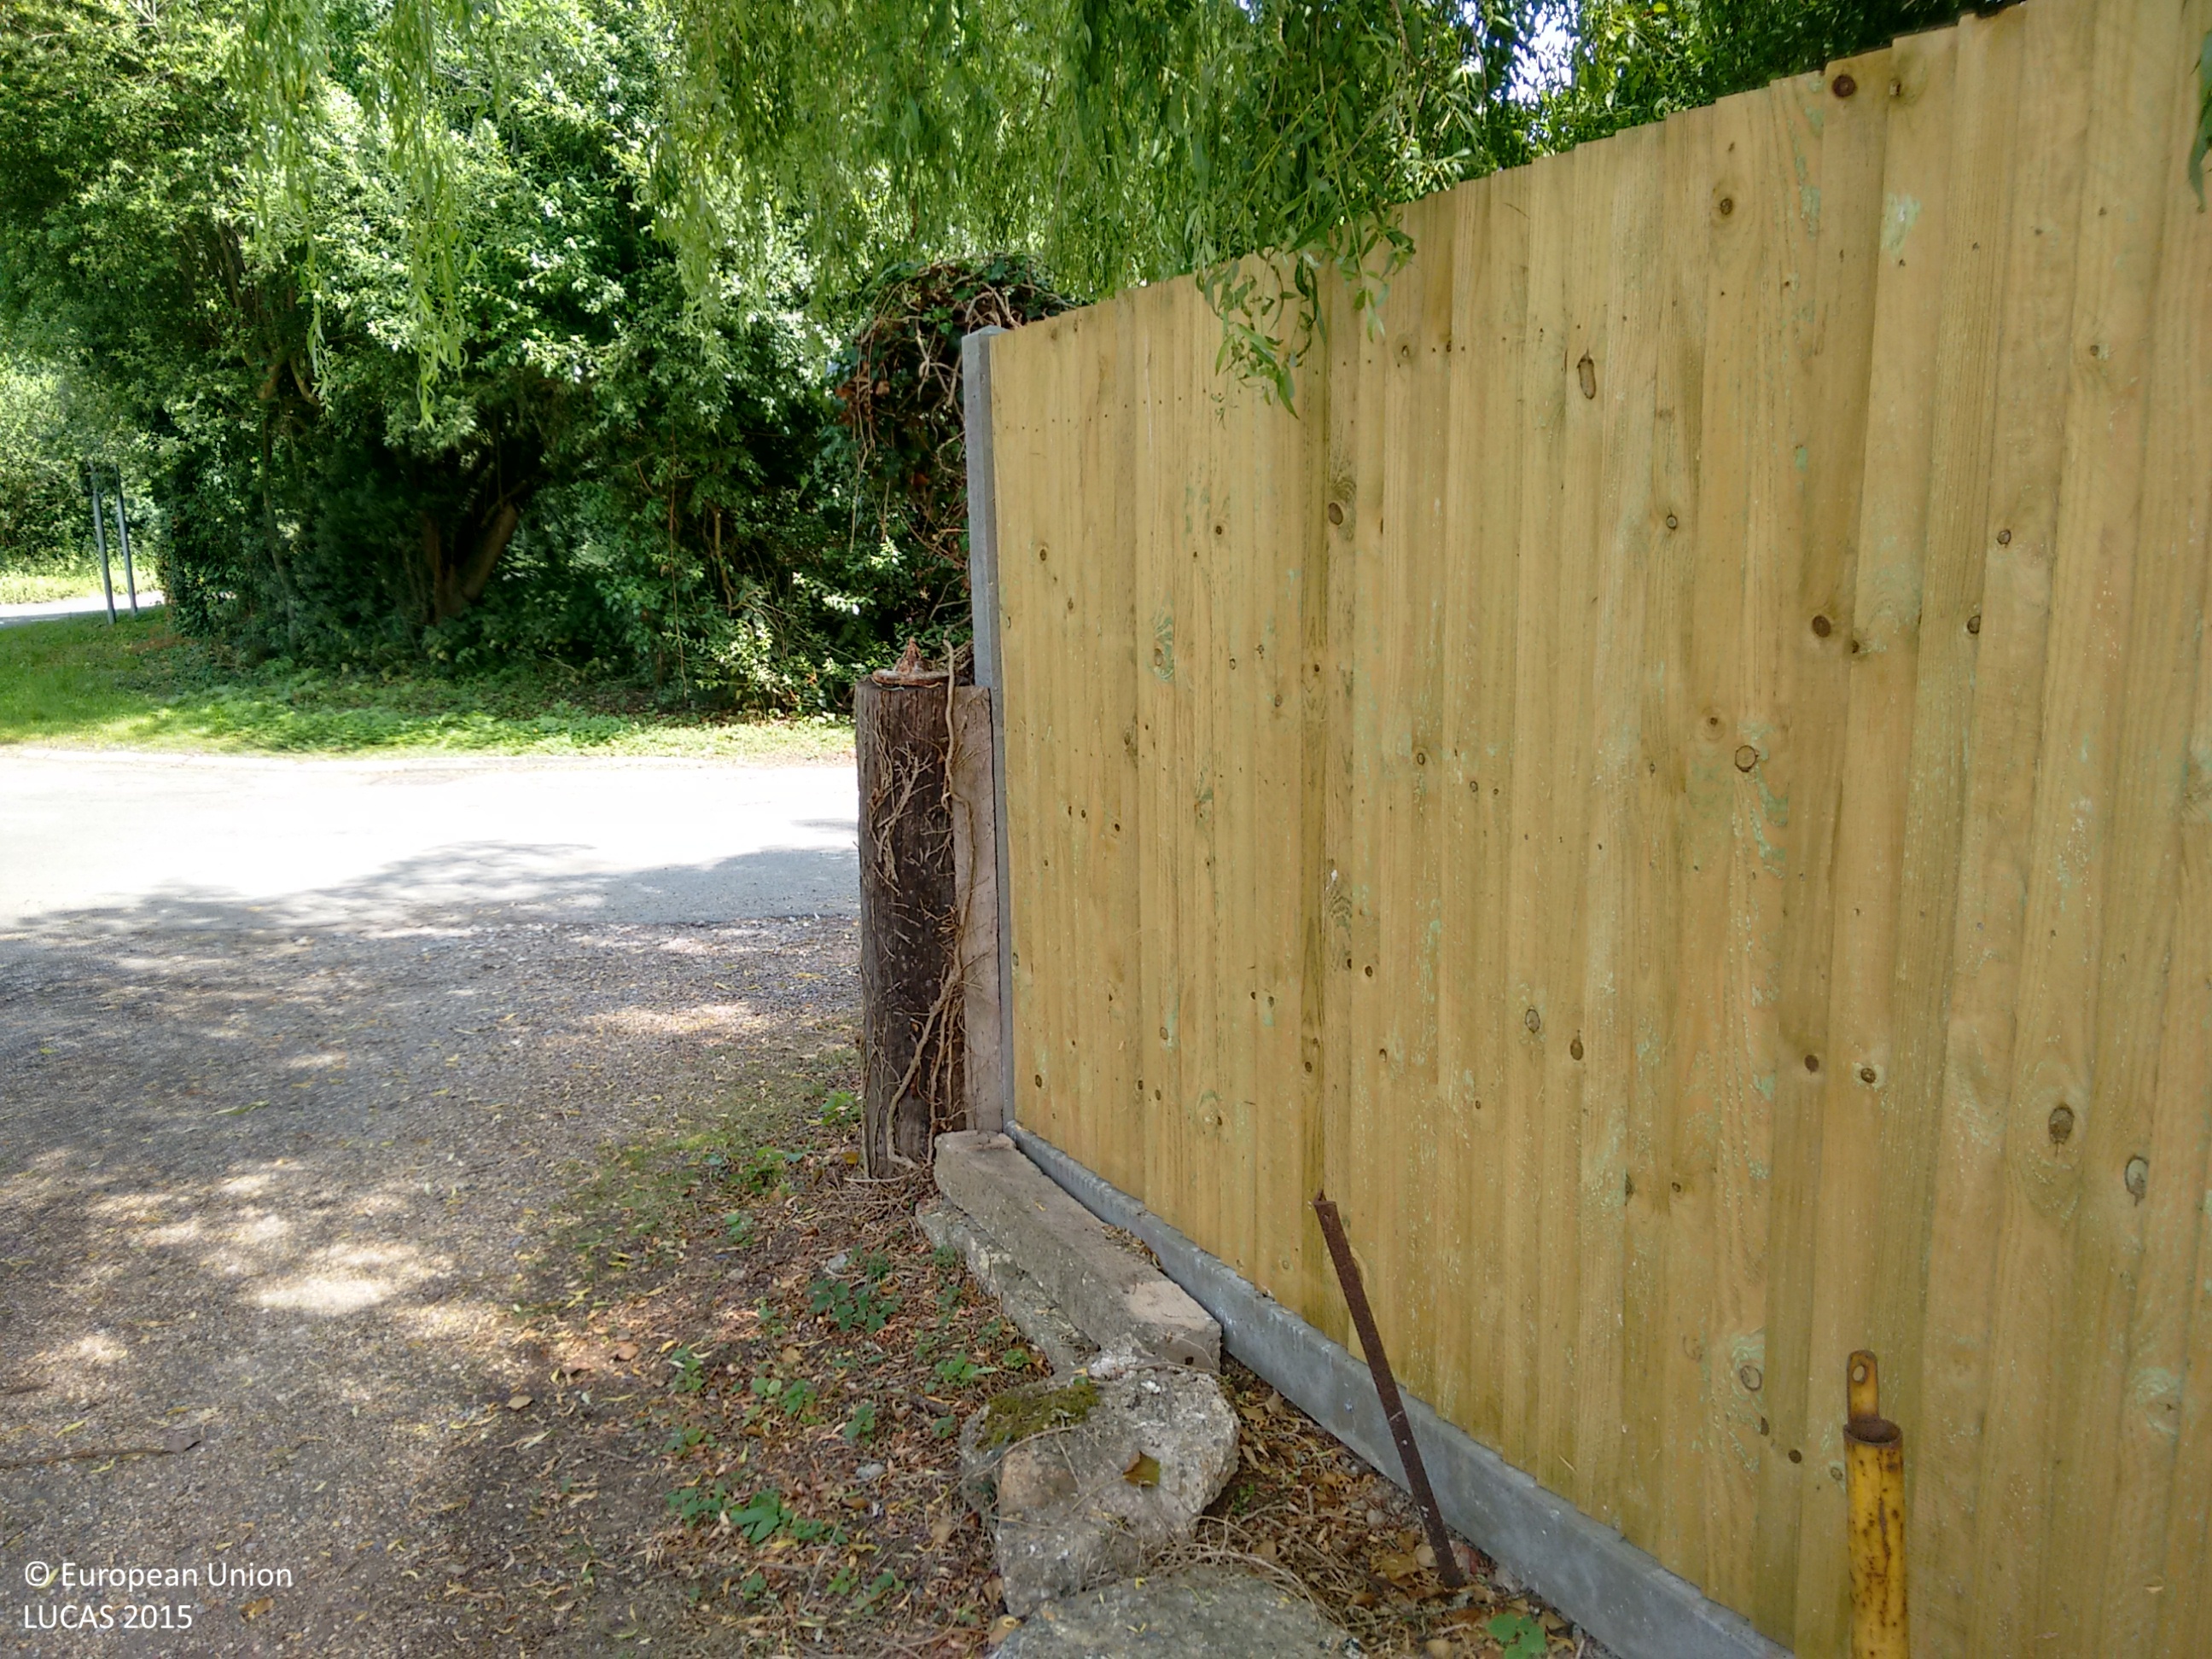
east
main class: Woodland
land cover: Broadleaved woodland
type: mesophytic deciduous forest
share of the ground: > 75 %
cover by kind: broadleaved forest trees 100 %
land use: Semi-natural and natural areas not in use
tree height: > 5 m
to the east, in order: Broadleaved woodland; Artificial constructions in urban areas; Broadleaved woodland; Fences; Broadleaved woodland; Inland fresh water bodies; Groves; Tracks; Groves; Inland fresh water bodies; Broadleaved woodland
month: July
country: GB
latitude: 50.9570
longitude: -0.4157
